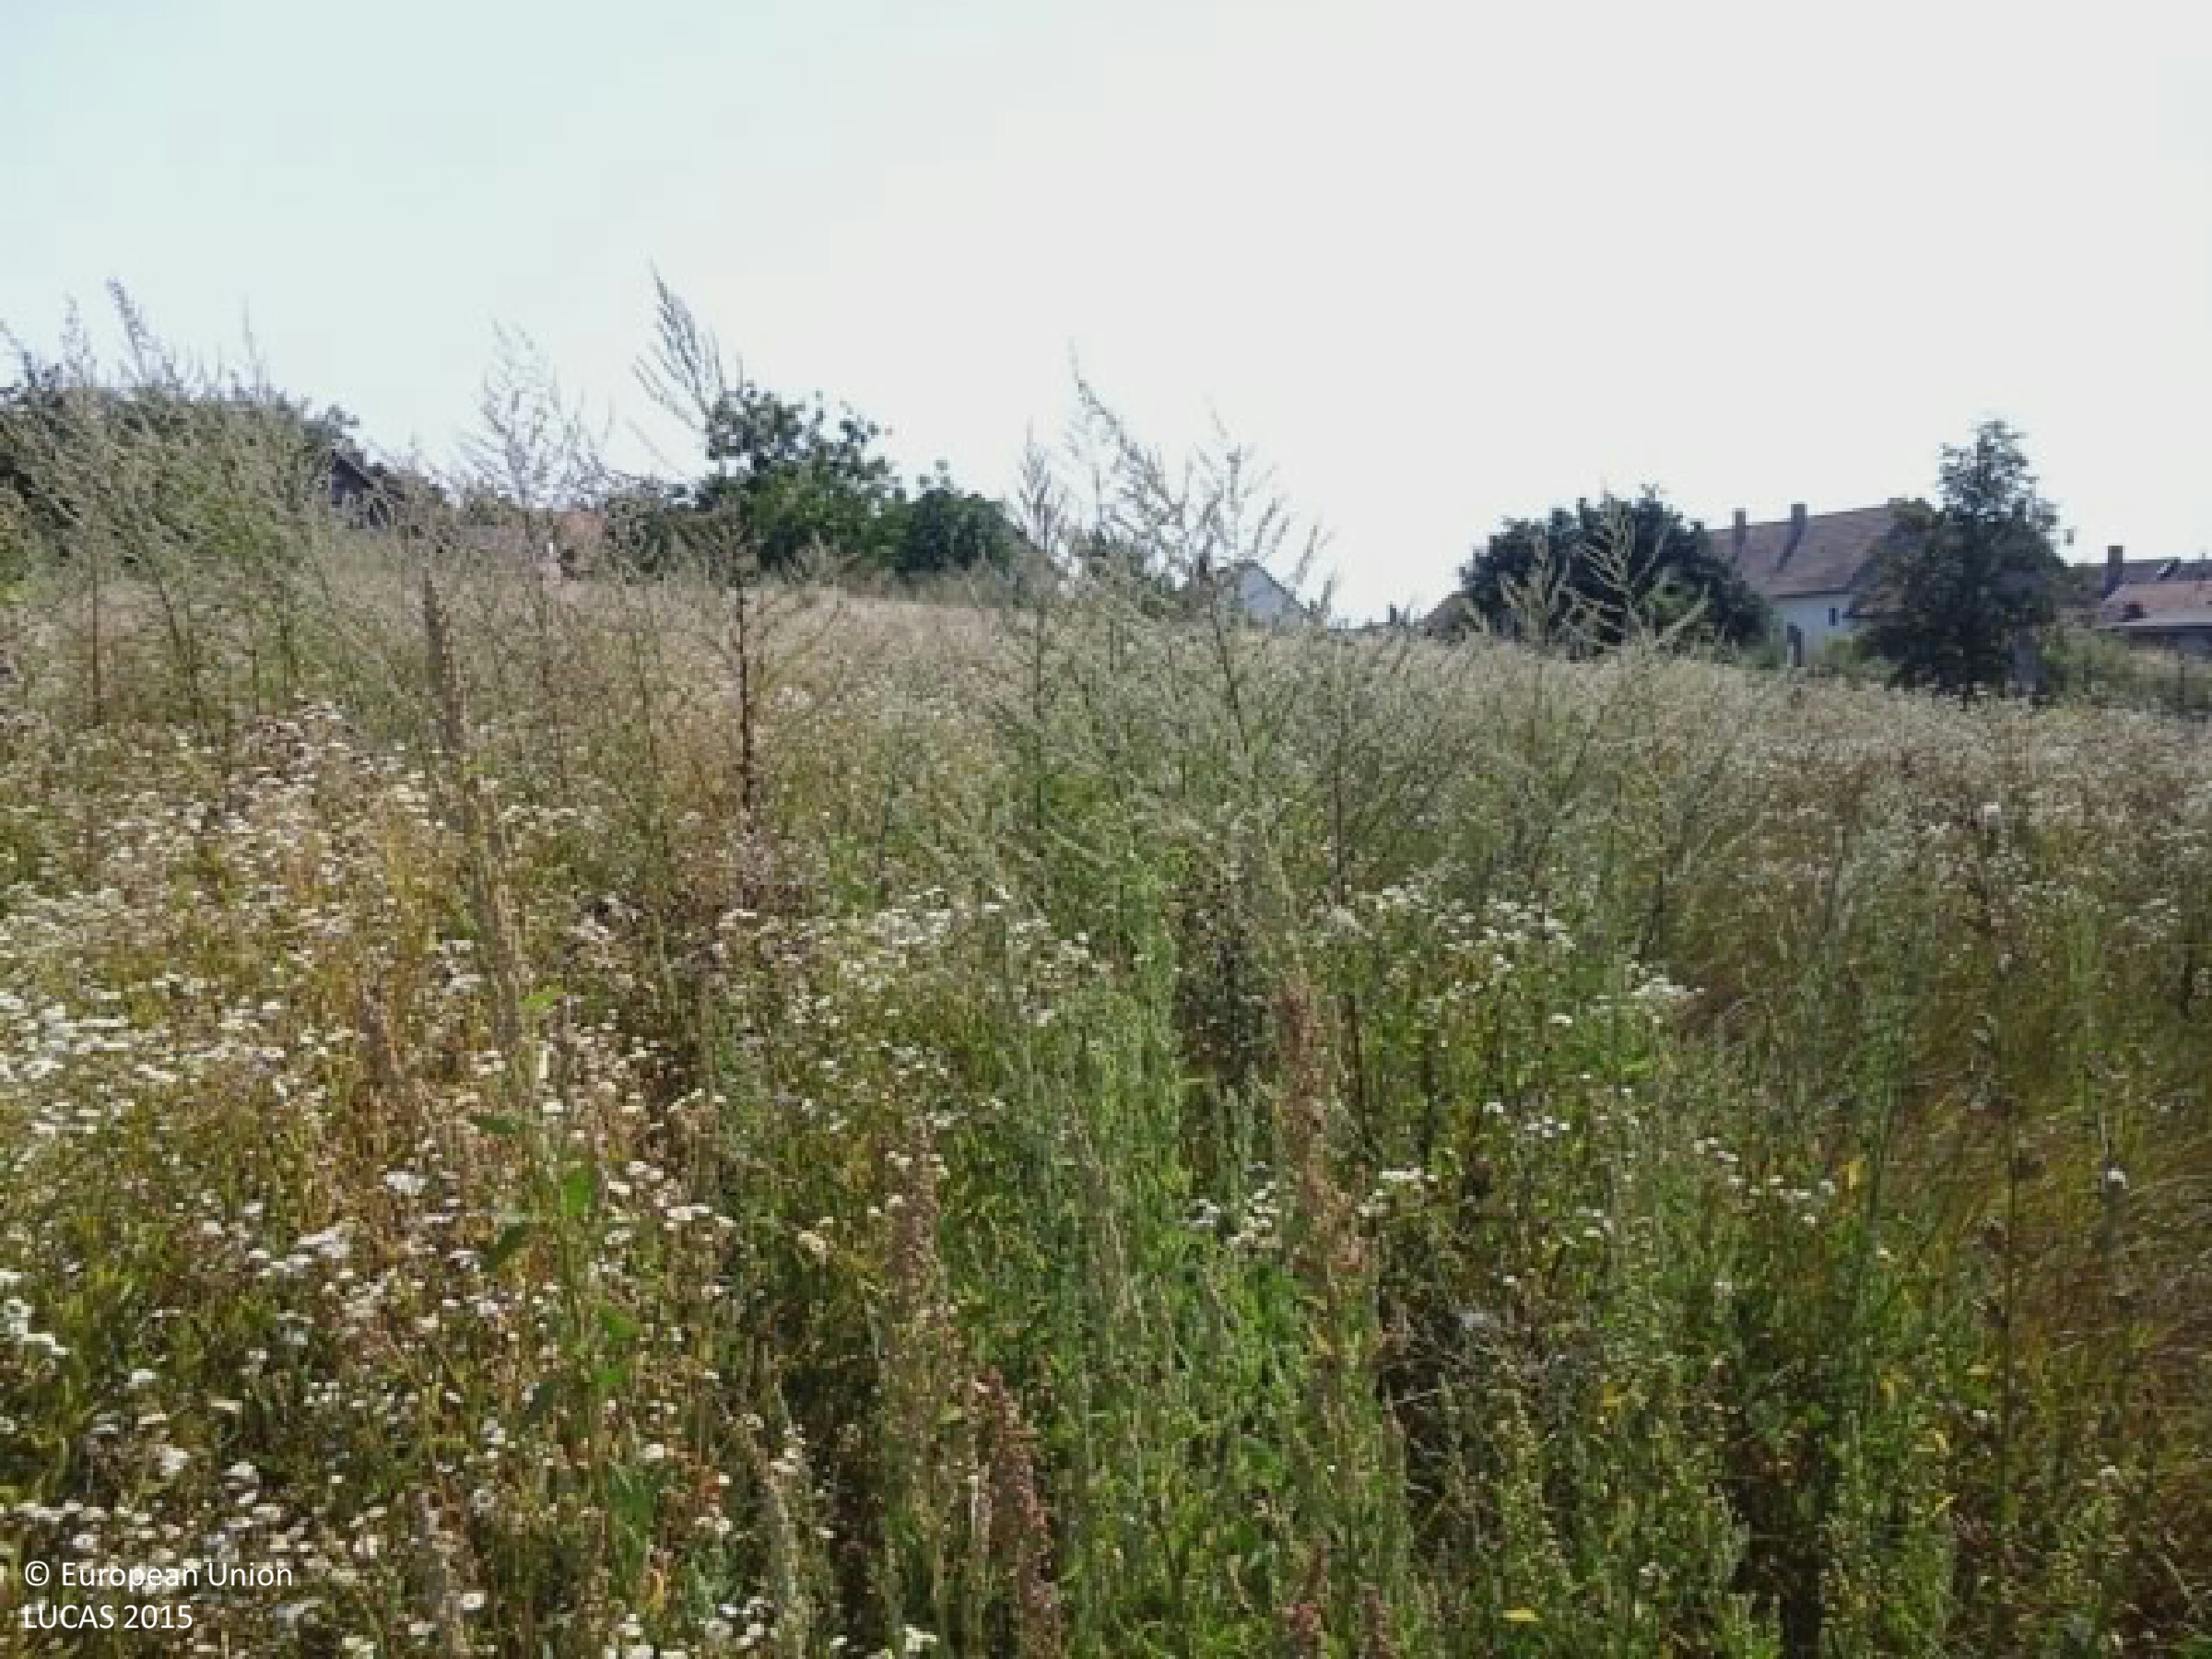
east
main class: Grassland
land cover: Spontaneously vegetated surfaces
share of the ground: > 75 %
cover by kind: herbaceous plants 100 %
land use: Residential
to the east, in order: Spontaneously vegetated surfaces; Artificial constructions in urban areas; Broadleaved woodland; Tracks; Managed hedges; Common wheat
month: August
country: HU
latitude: 46.5889
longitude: 17.8247
